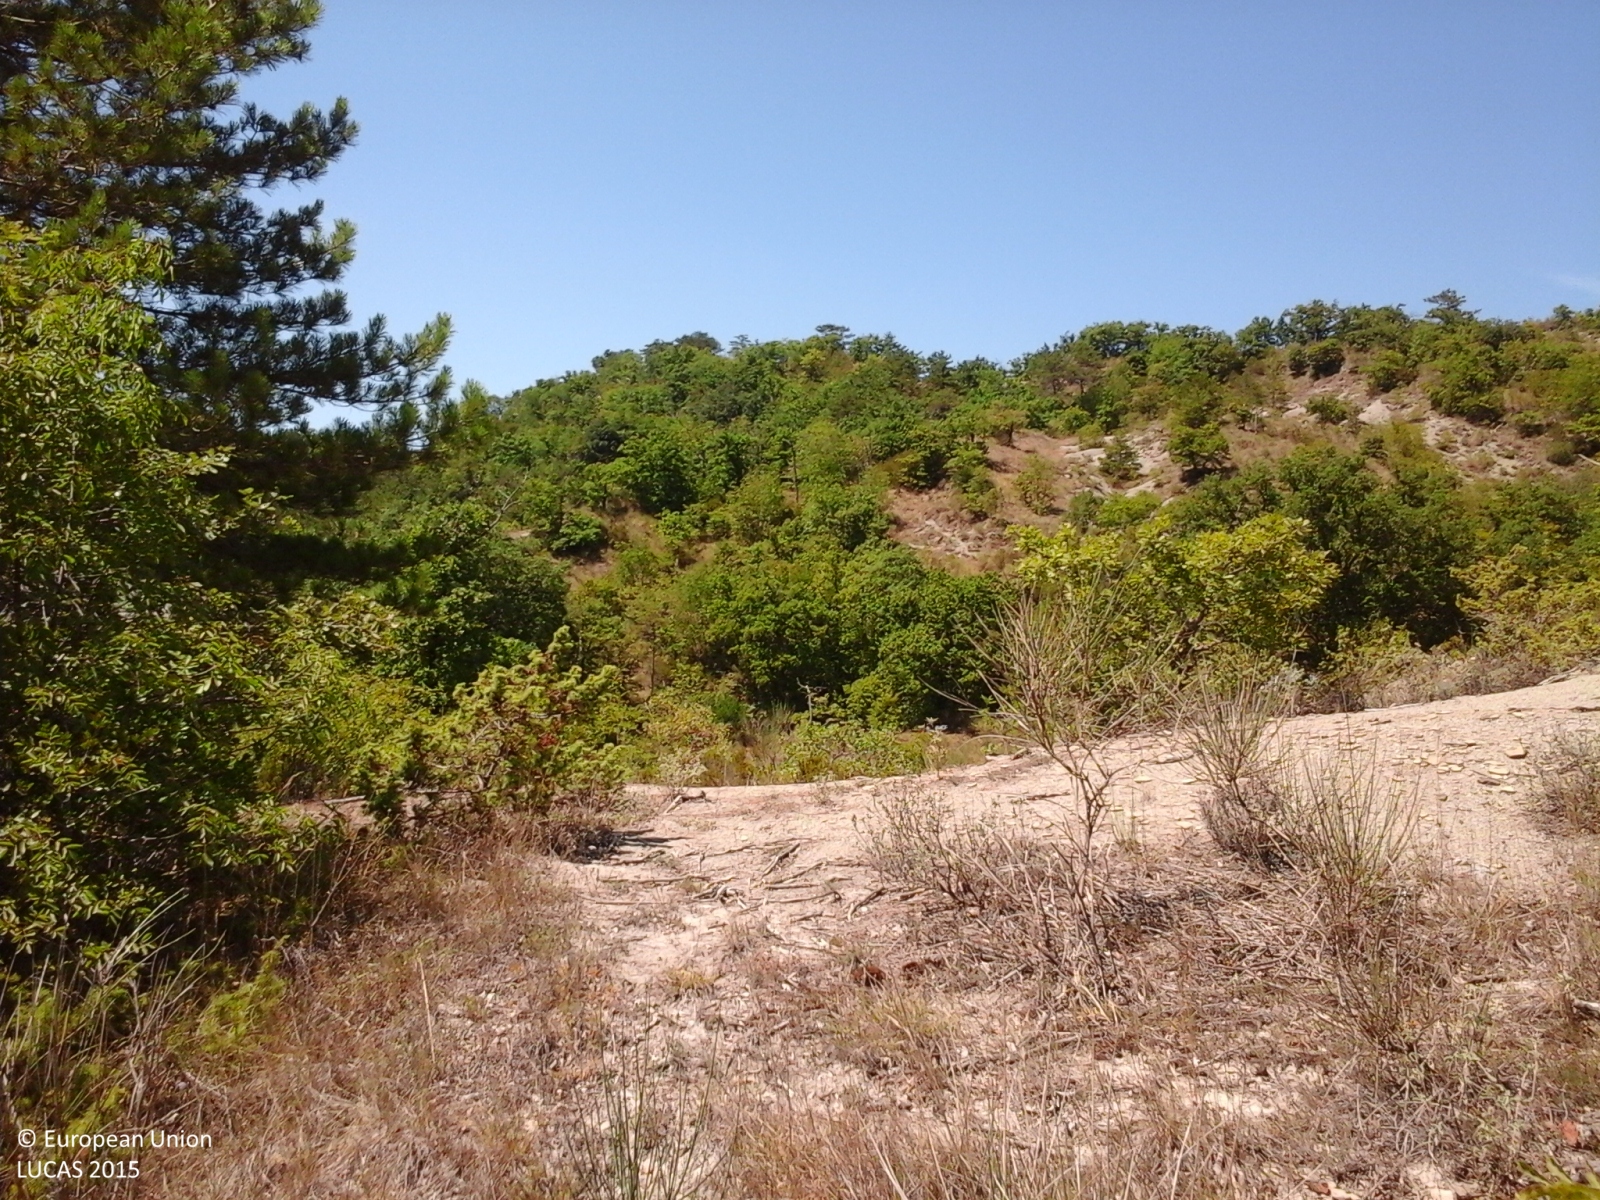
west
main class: Shrubland
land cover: Shrubland with sparse tree cover
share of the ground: > 75 %
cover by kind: shrubs 95 %, broadleaved forest trees 5 %
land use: Forestry
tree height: > 5 m
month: August
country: IT
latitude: 43.4772
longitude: 12.2810
